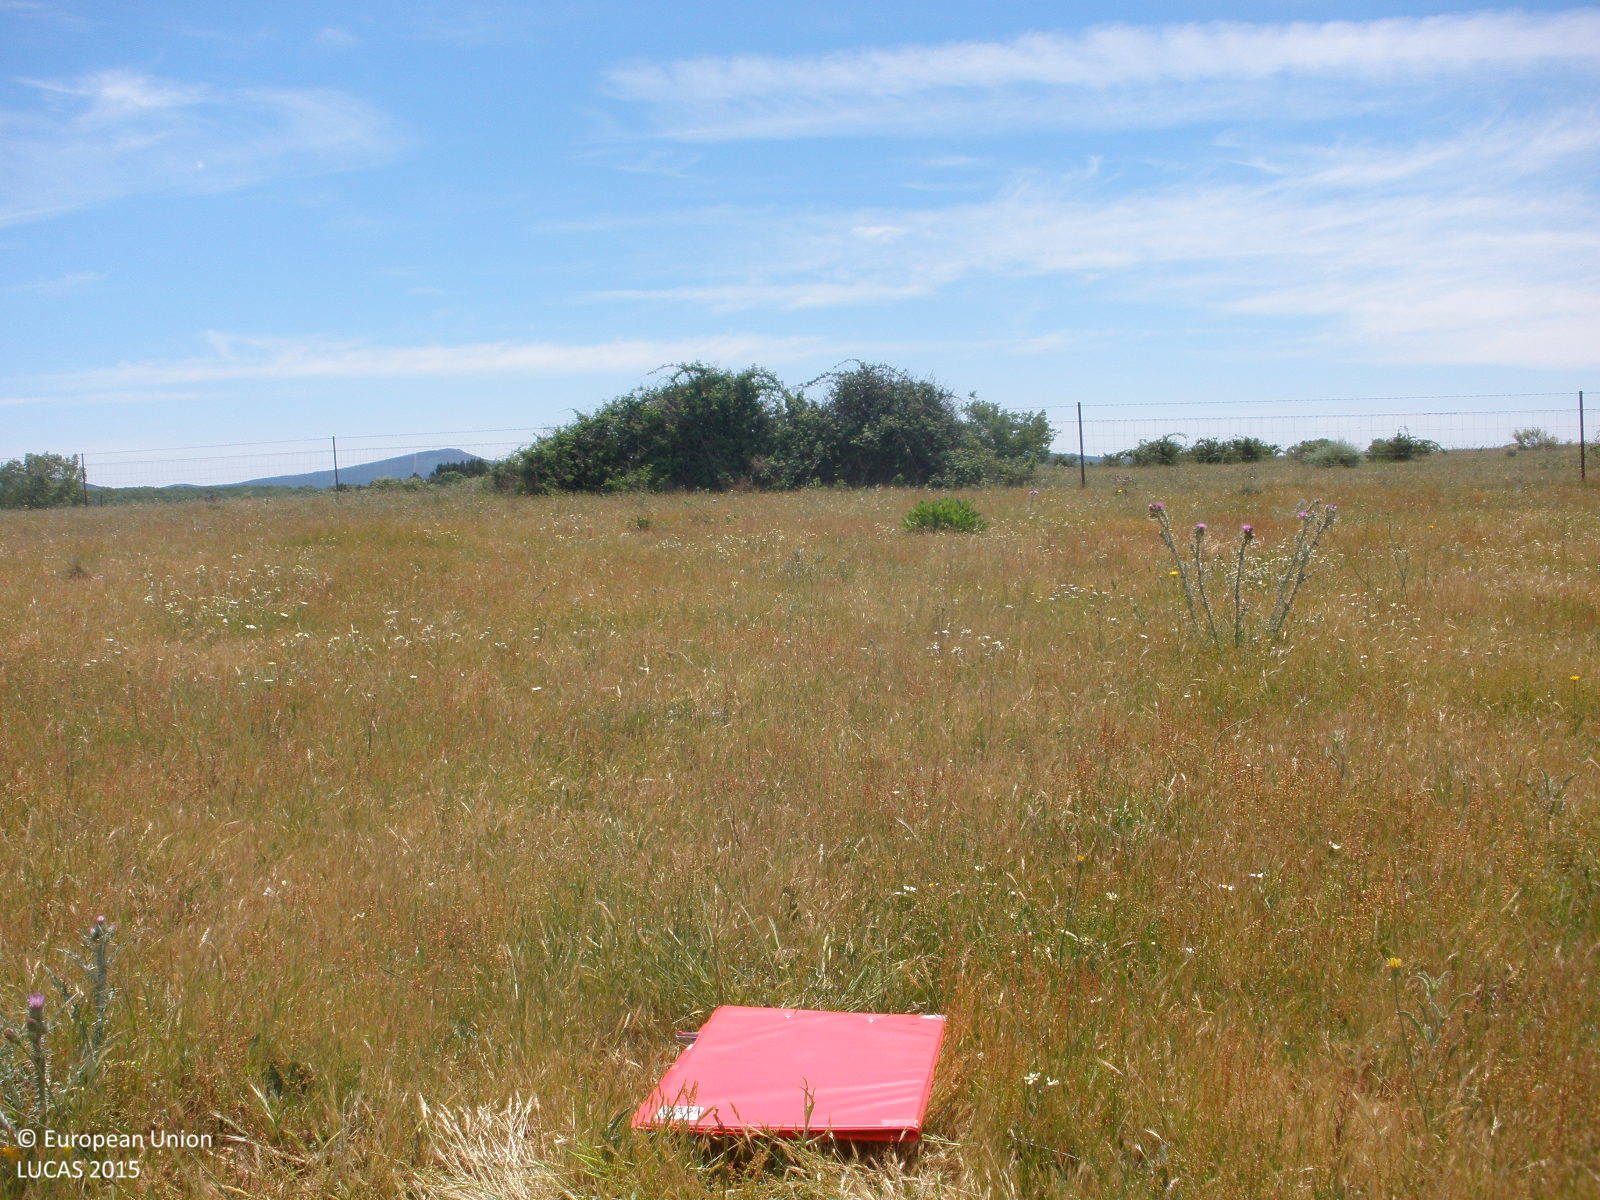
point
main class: Grassland
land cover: Grassland without tree/shrub cover
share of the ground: > 75 %
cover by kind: herbaceous plants 100 %
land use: Agriculture (excluding fallow land and kitchen gardens)
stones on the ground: < 10 %
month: May
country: ES
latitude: 40.3788
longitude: -6.6616
